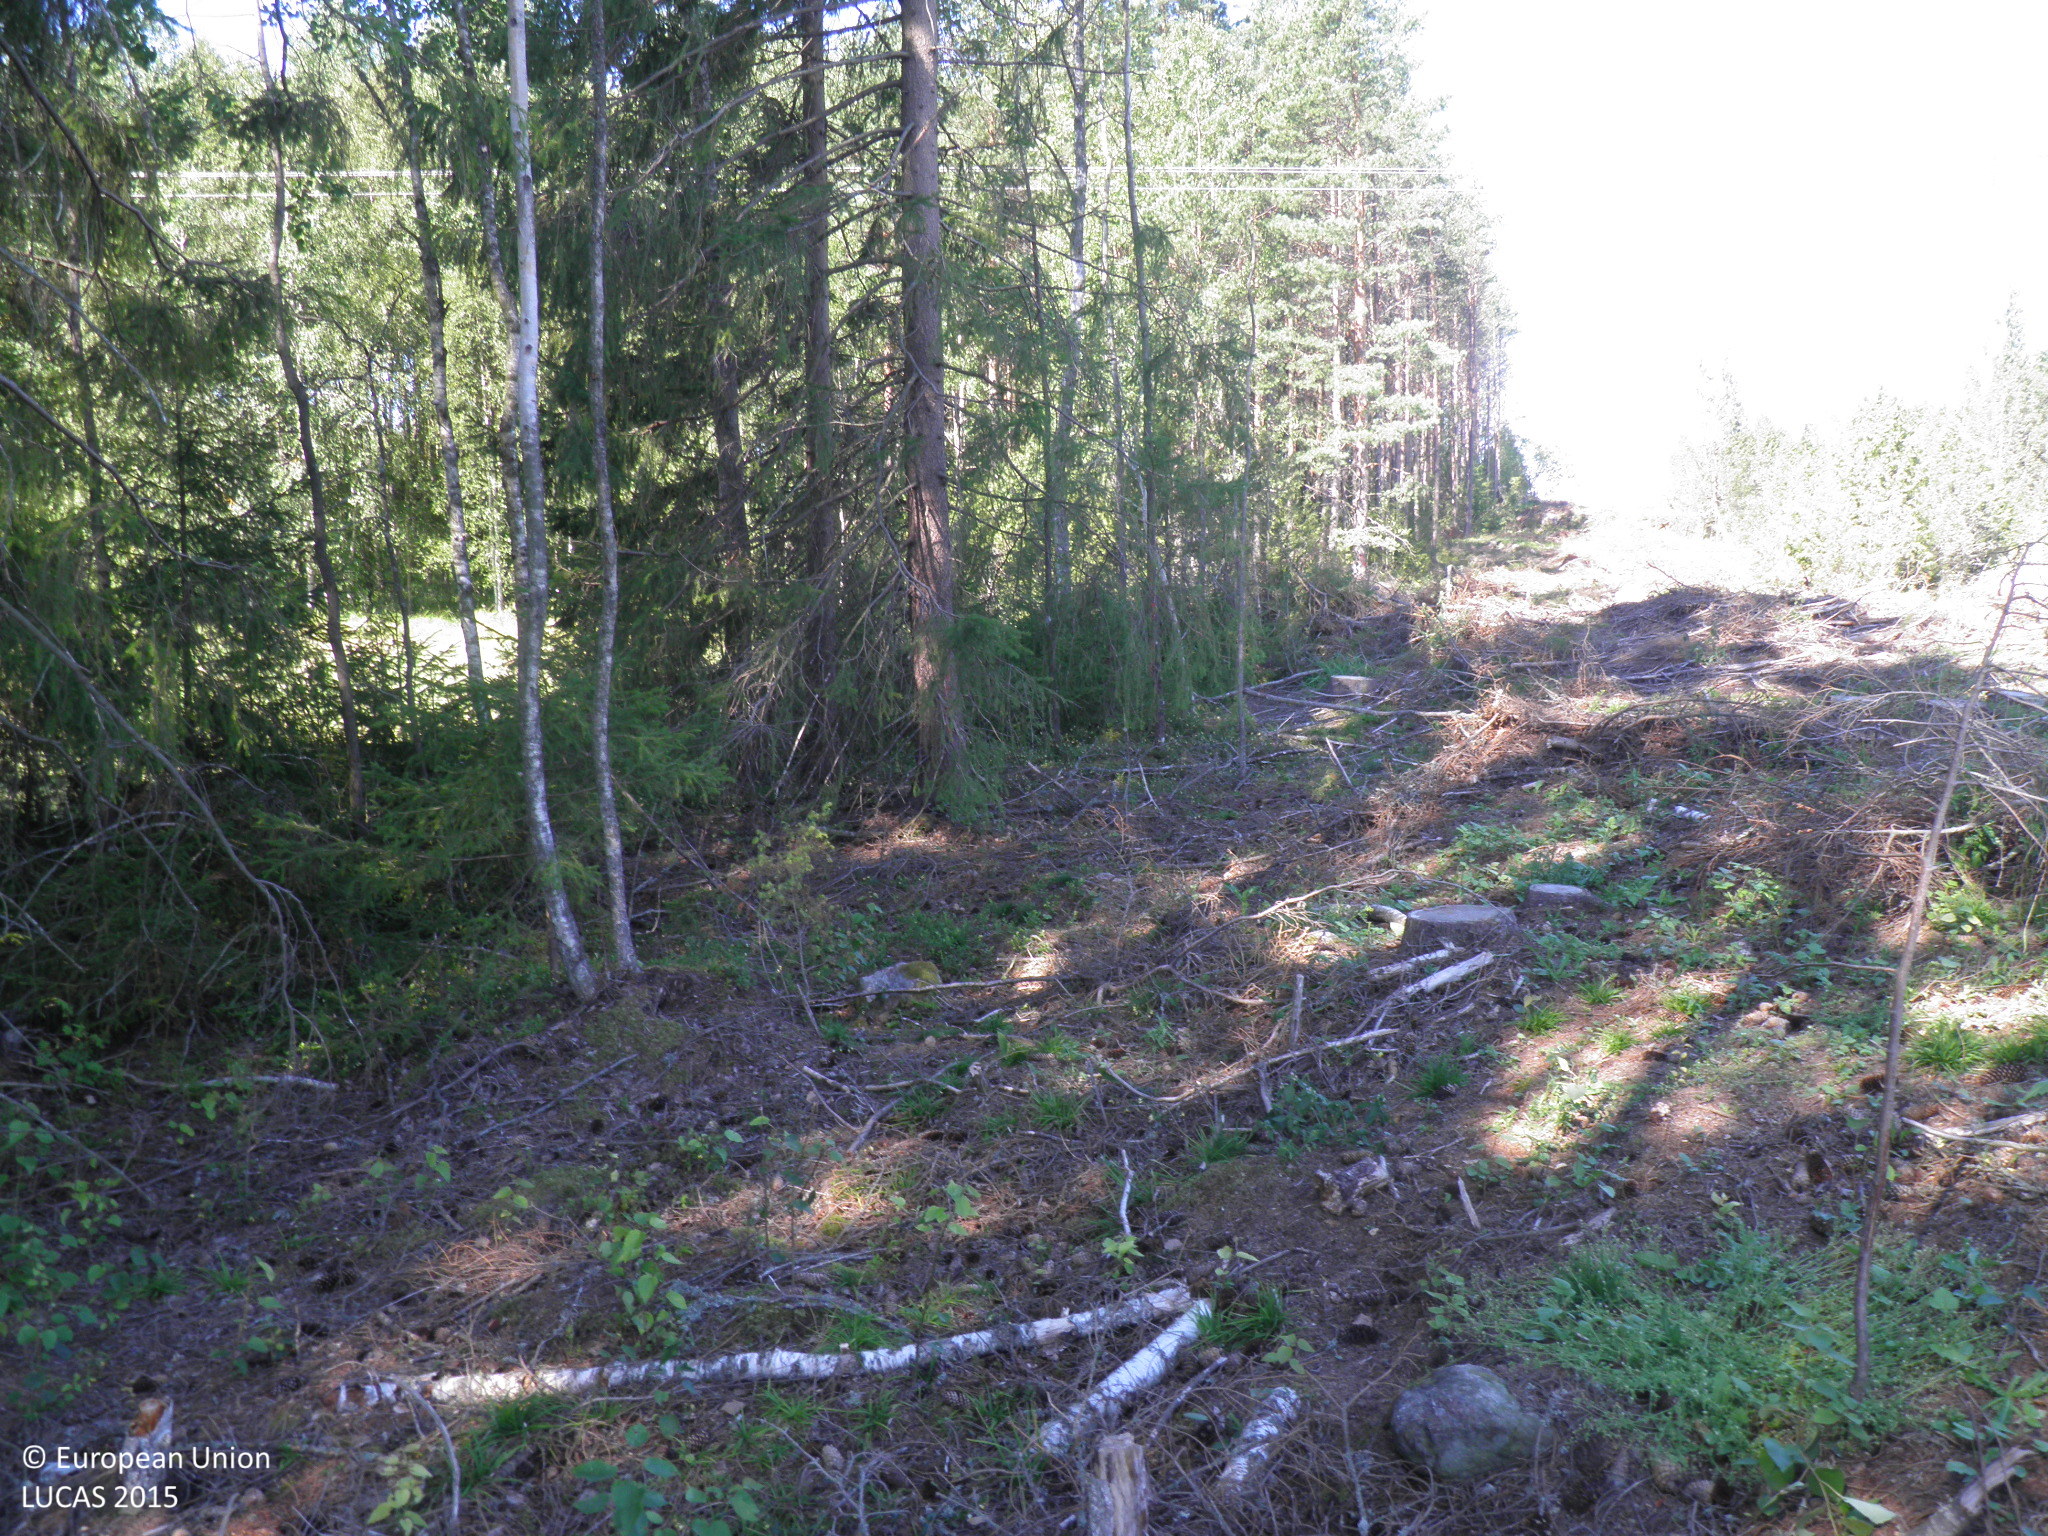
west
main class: Grassland
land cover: Spontaneously vegetated surfaces
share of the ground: 10 - 25 %
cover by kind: unconsolidated bare surface 70 %, herbaceous plants 15 %, shrubs 5 %
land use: Forestry
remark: Clear cut
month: August
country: FI
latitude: 60.7694
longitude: 21.6779
